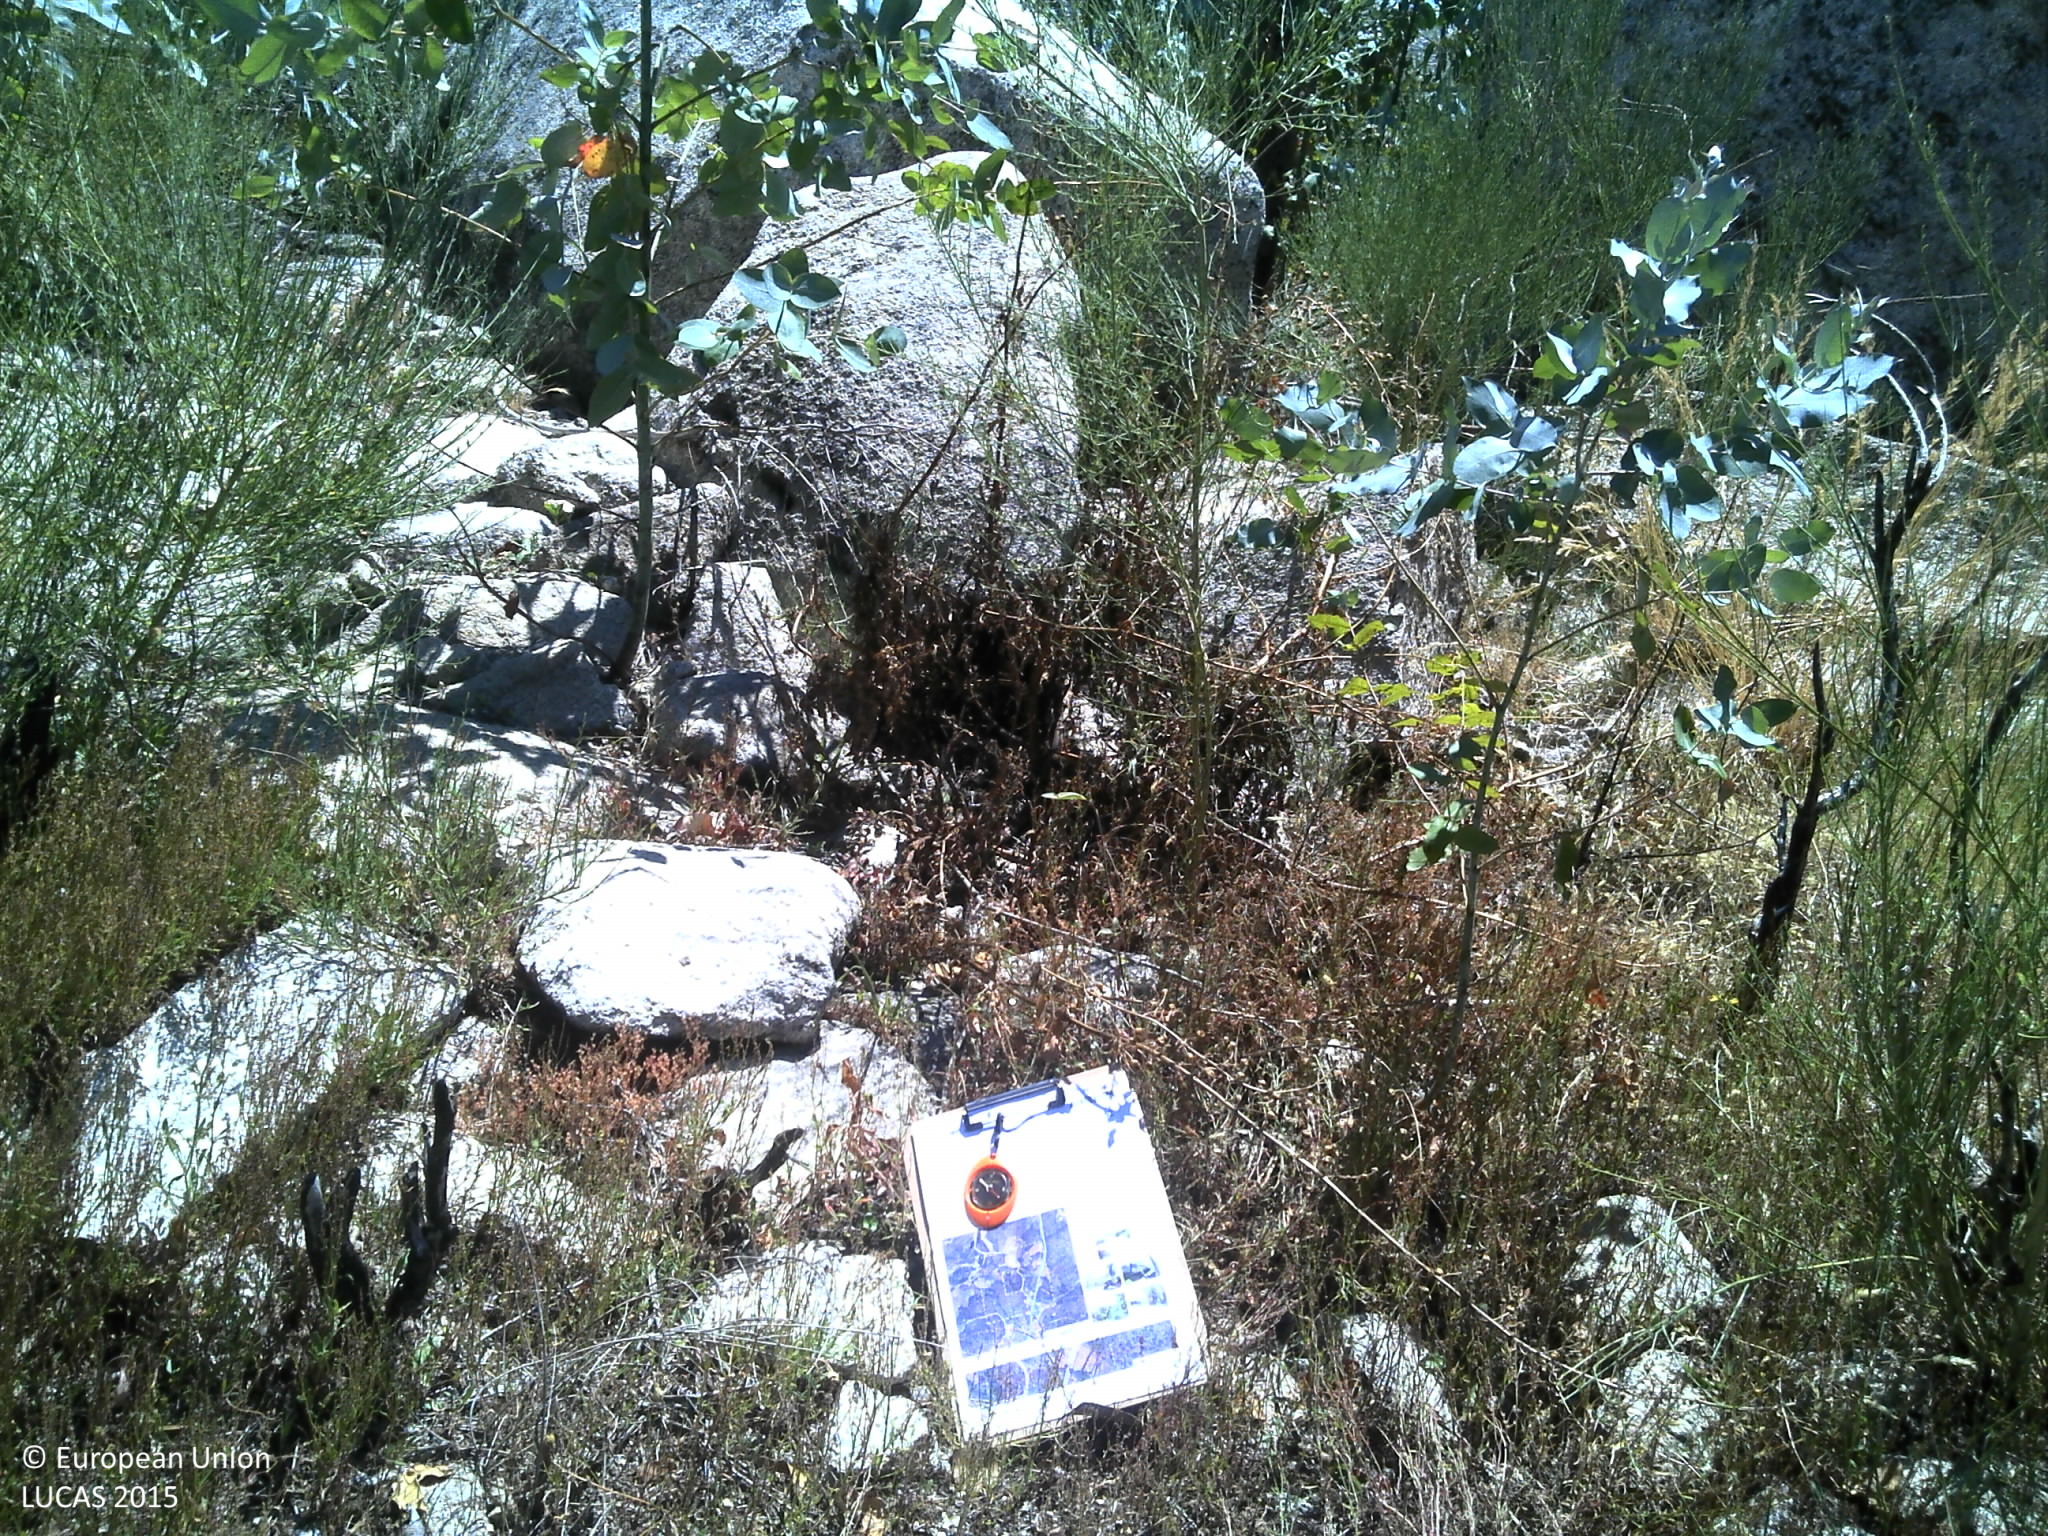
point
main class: Woodland
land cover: Broadleaved woodland
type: exotic forest
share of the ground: 50 - 75 %
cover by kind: broadleaved forest trees 50 %, consolidated bare surface 25 %, shrubs 10 %, herbaceous plants 10 %, unconsolidated bare surface 5 %
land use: Forestry
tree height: < 5 m
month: June
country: PT
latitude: 40.5569
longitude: -8.2358
